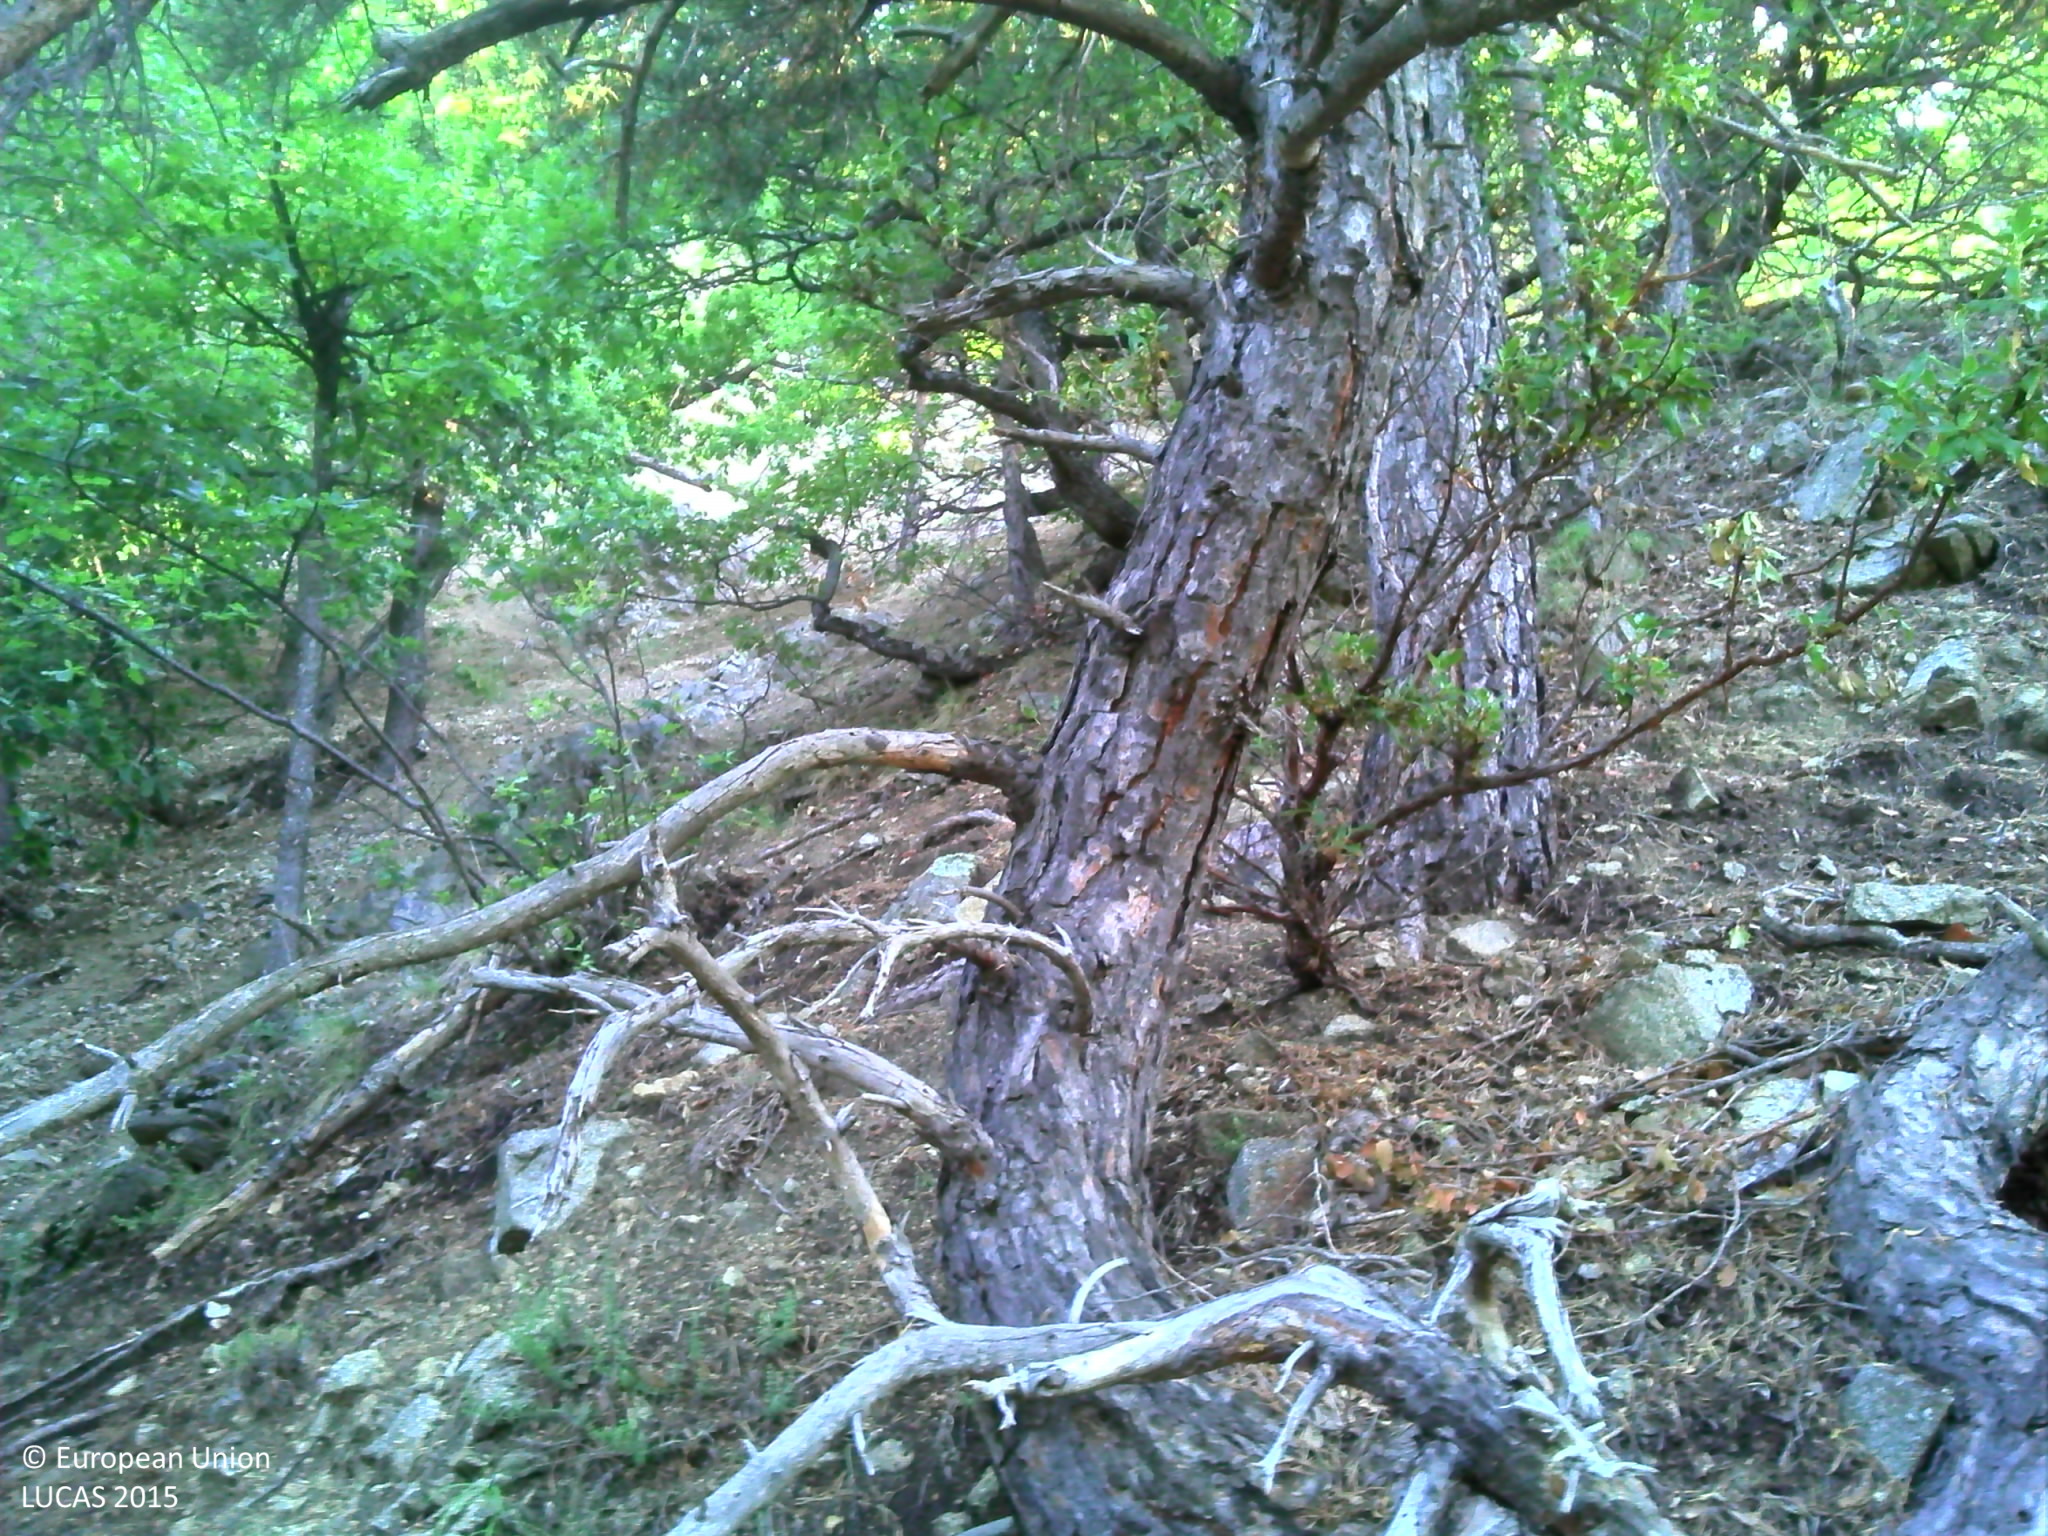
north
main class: Woodland
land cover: Pine dominated mixed woodland
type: mesophytic deciduous forest
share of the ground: > 75 %
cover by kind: broadleaved forest trees 55 %, coniferous forest trees 40 %, unconsolidated bare surface 5 %
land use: Semi-natural and natural areas not in use
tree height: > 5 m
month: July
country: FR
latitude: 42.5150
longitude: 2.1851
